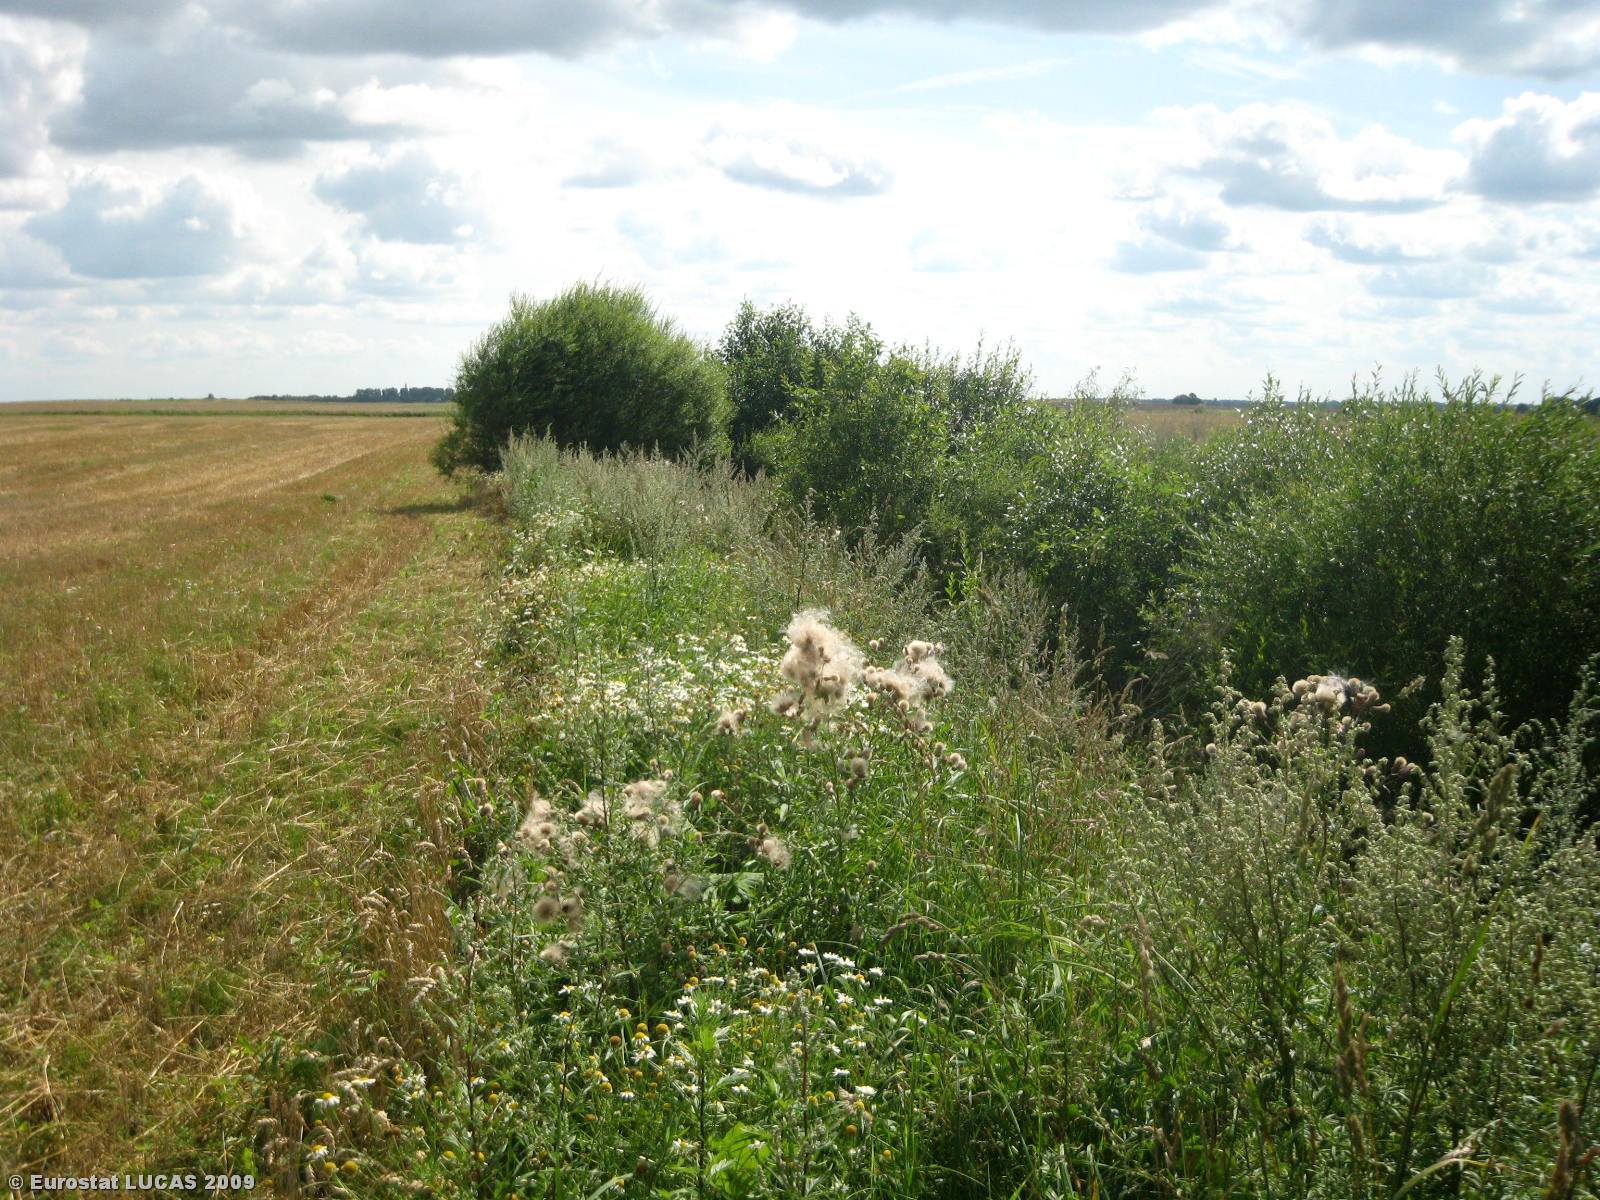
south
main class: Grassland
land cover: Spontaneously vegetated surfaces
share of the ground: > 75 %
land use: Fallow land
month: August
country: LT
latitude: 55.3783
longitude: 23.6711
